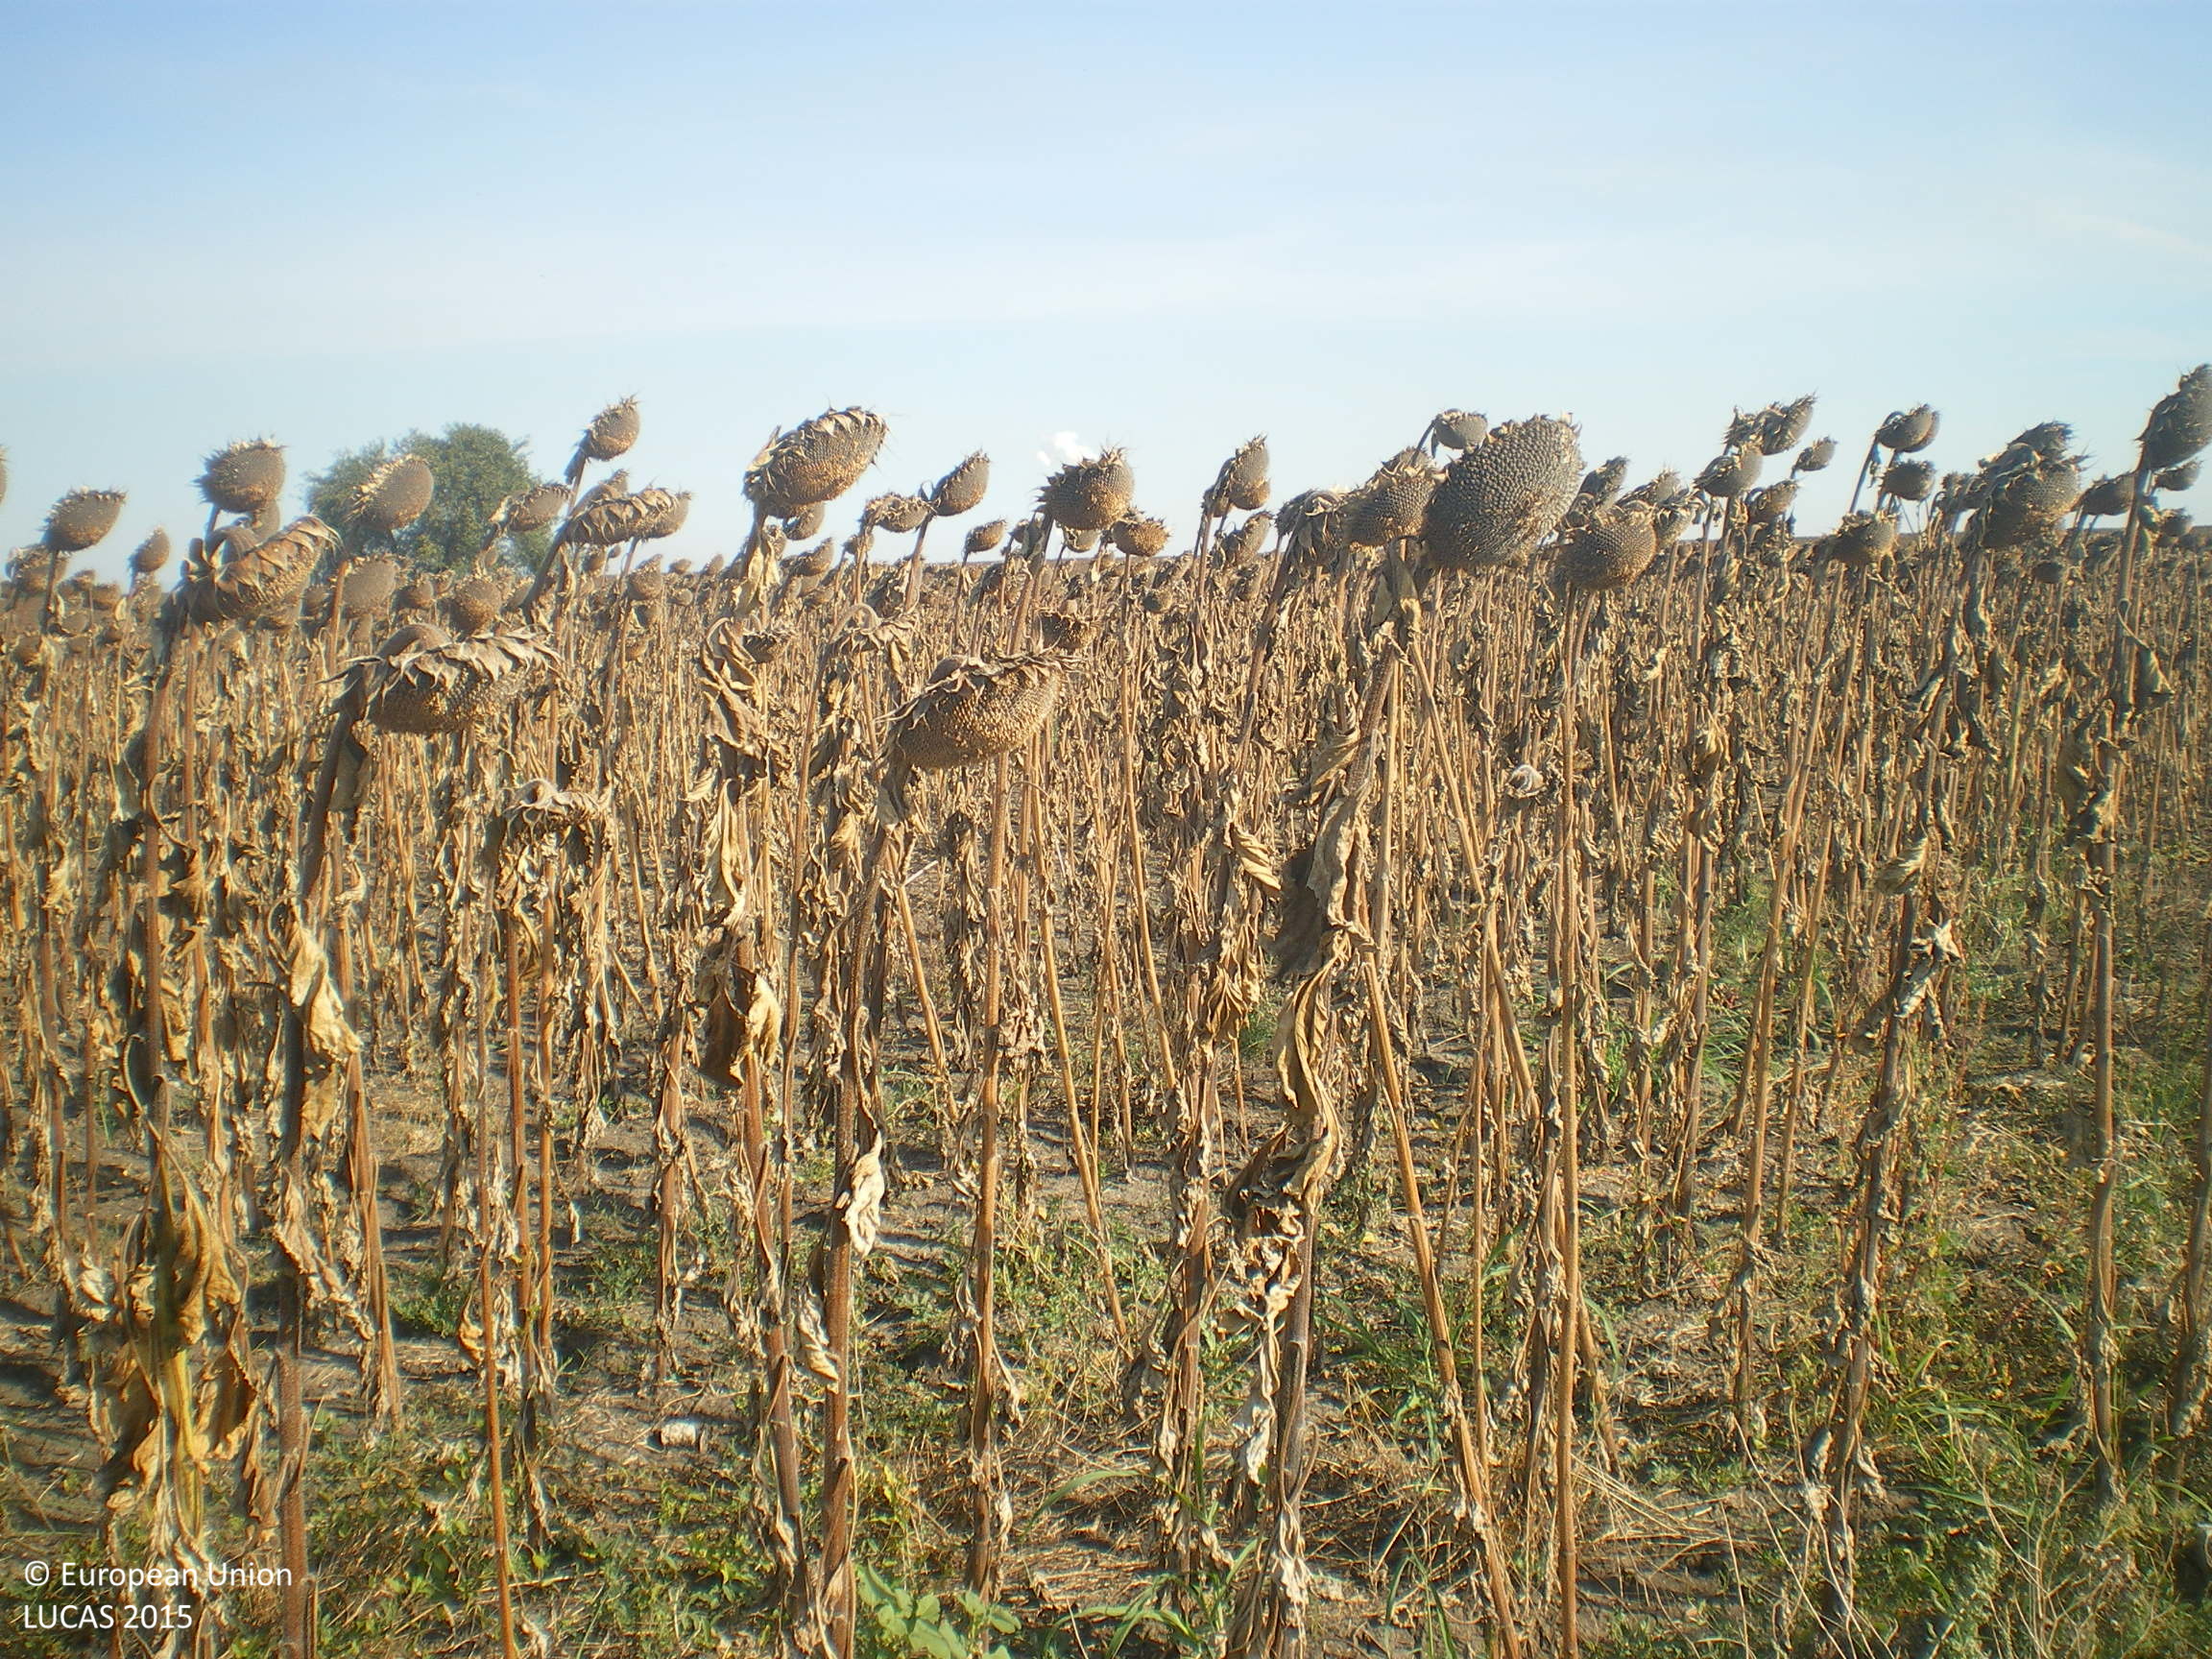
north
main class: Cropland
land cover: Sunflower
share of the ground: > 75 %
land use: Agriculture (excluding fallow land and kitchen gardens)
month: September
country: BG
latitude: 42.0871
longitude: 25.8983
